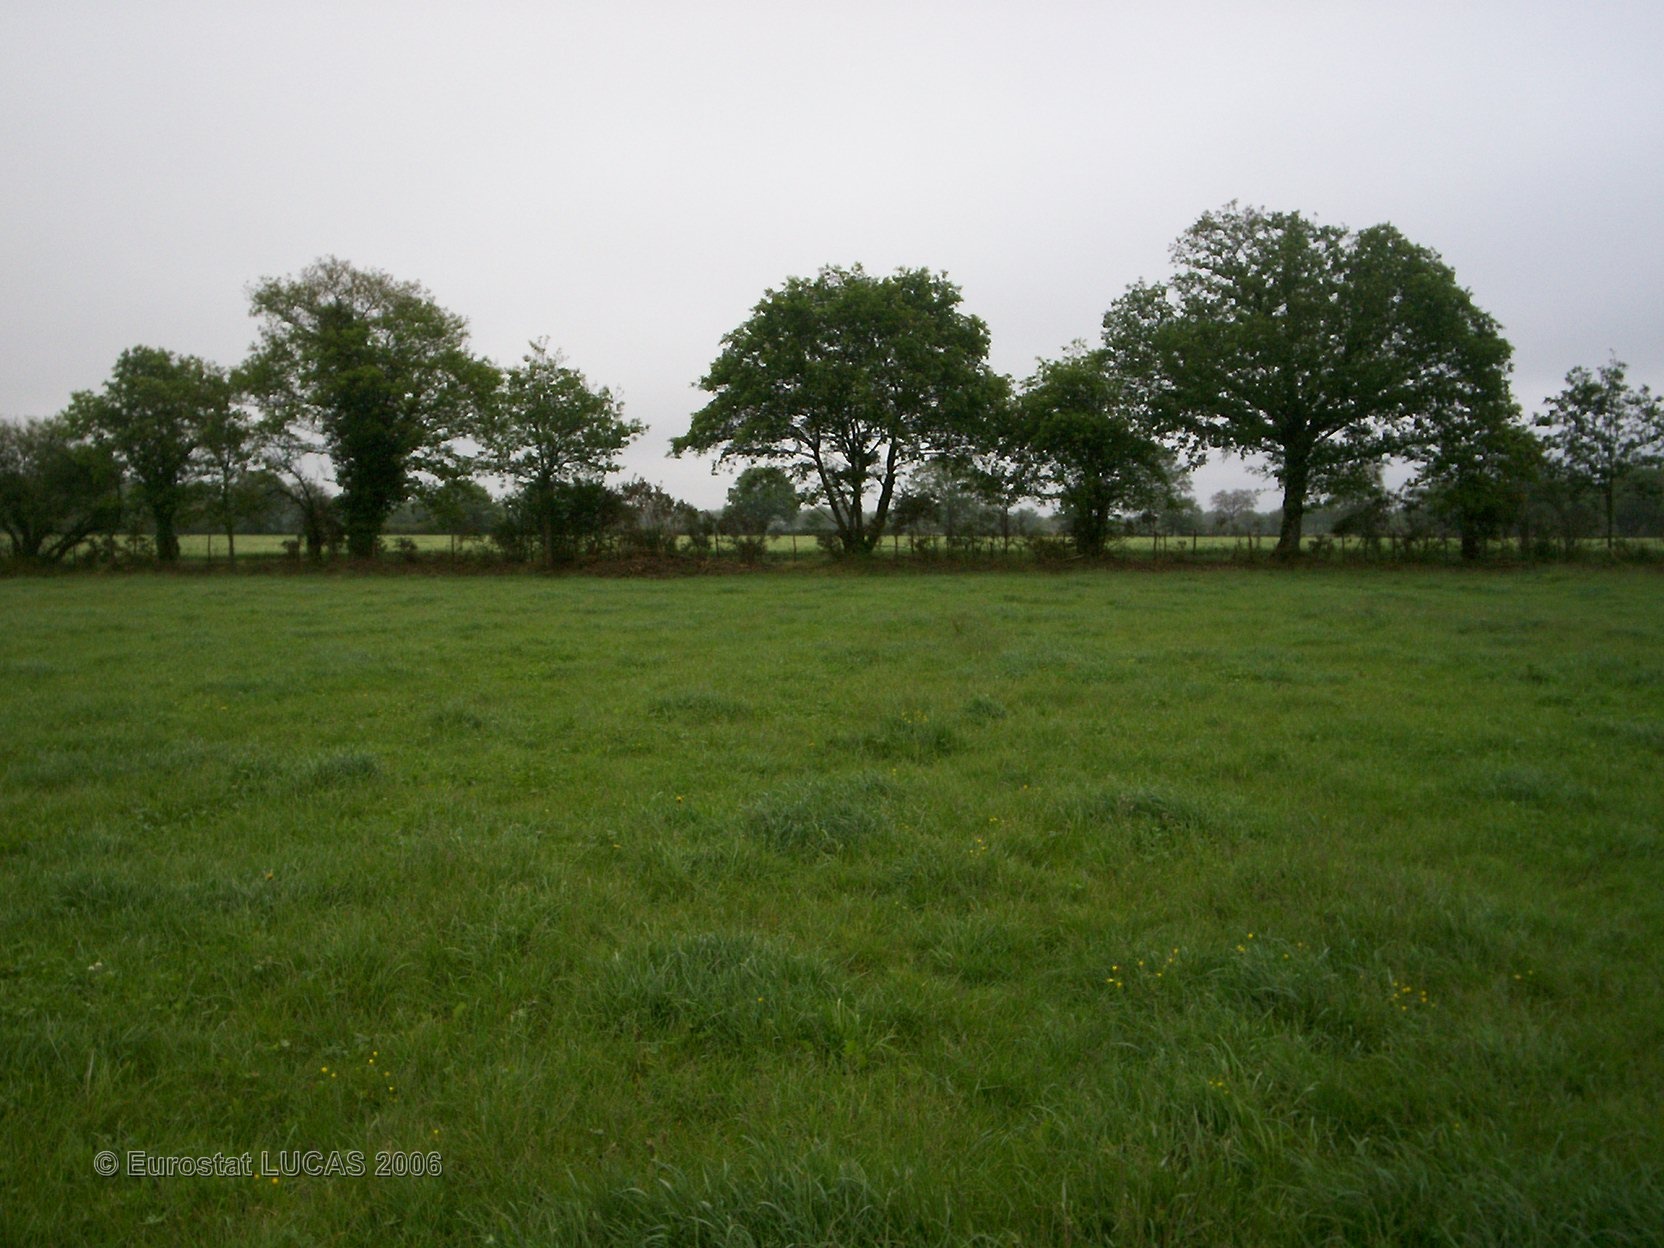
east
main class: Grassland
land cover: Grassland without tree/shrub cover
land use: Agriculture (excluding fallow land and kitchen gardens)
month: May
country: FR
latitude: 47.5486
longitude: -1.4833
